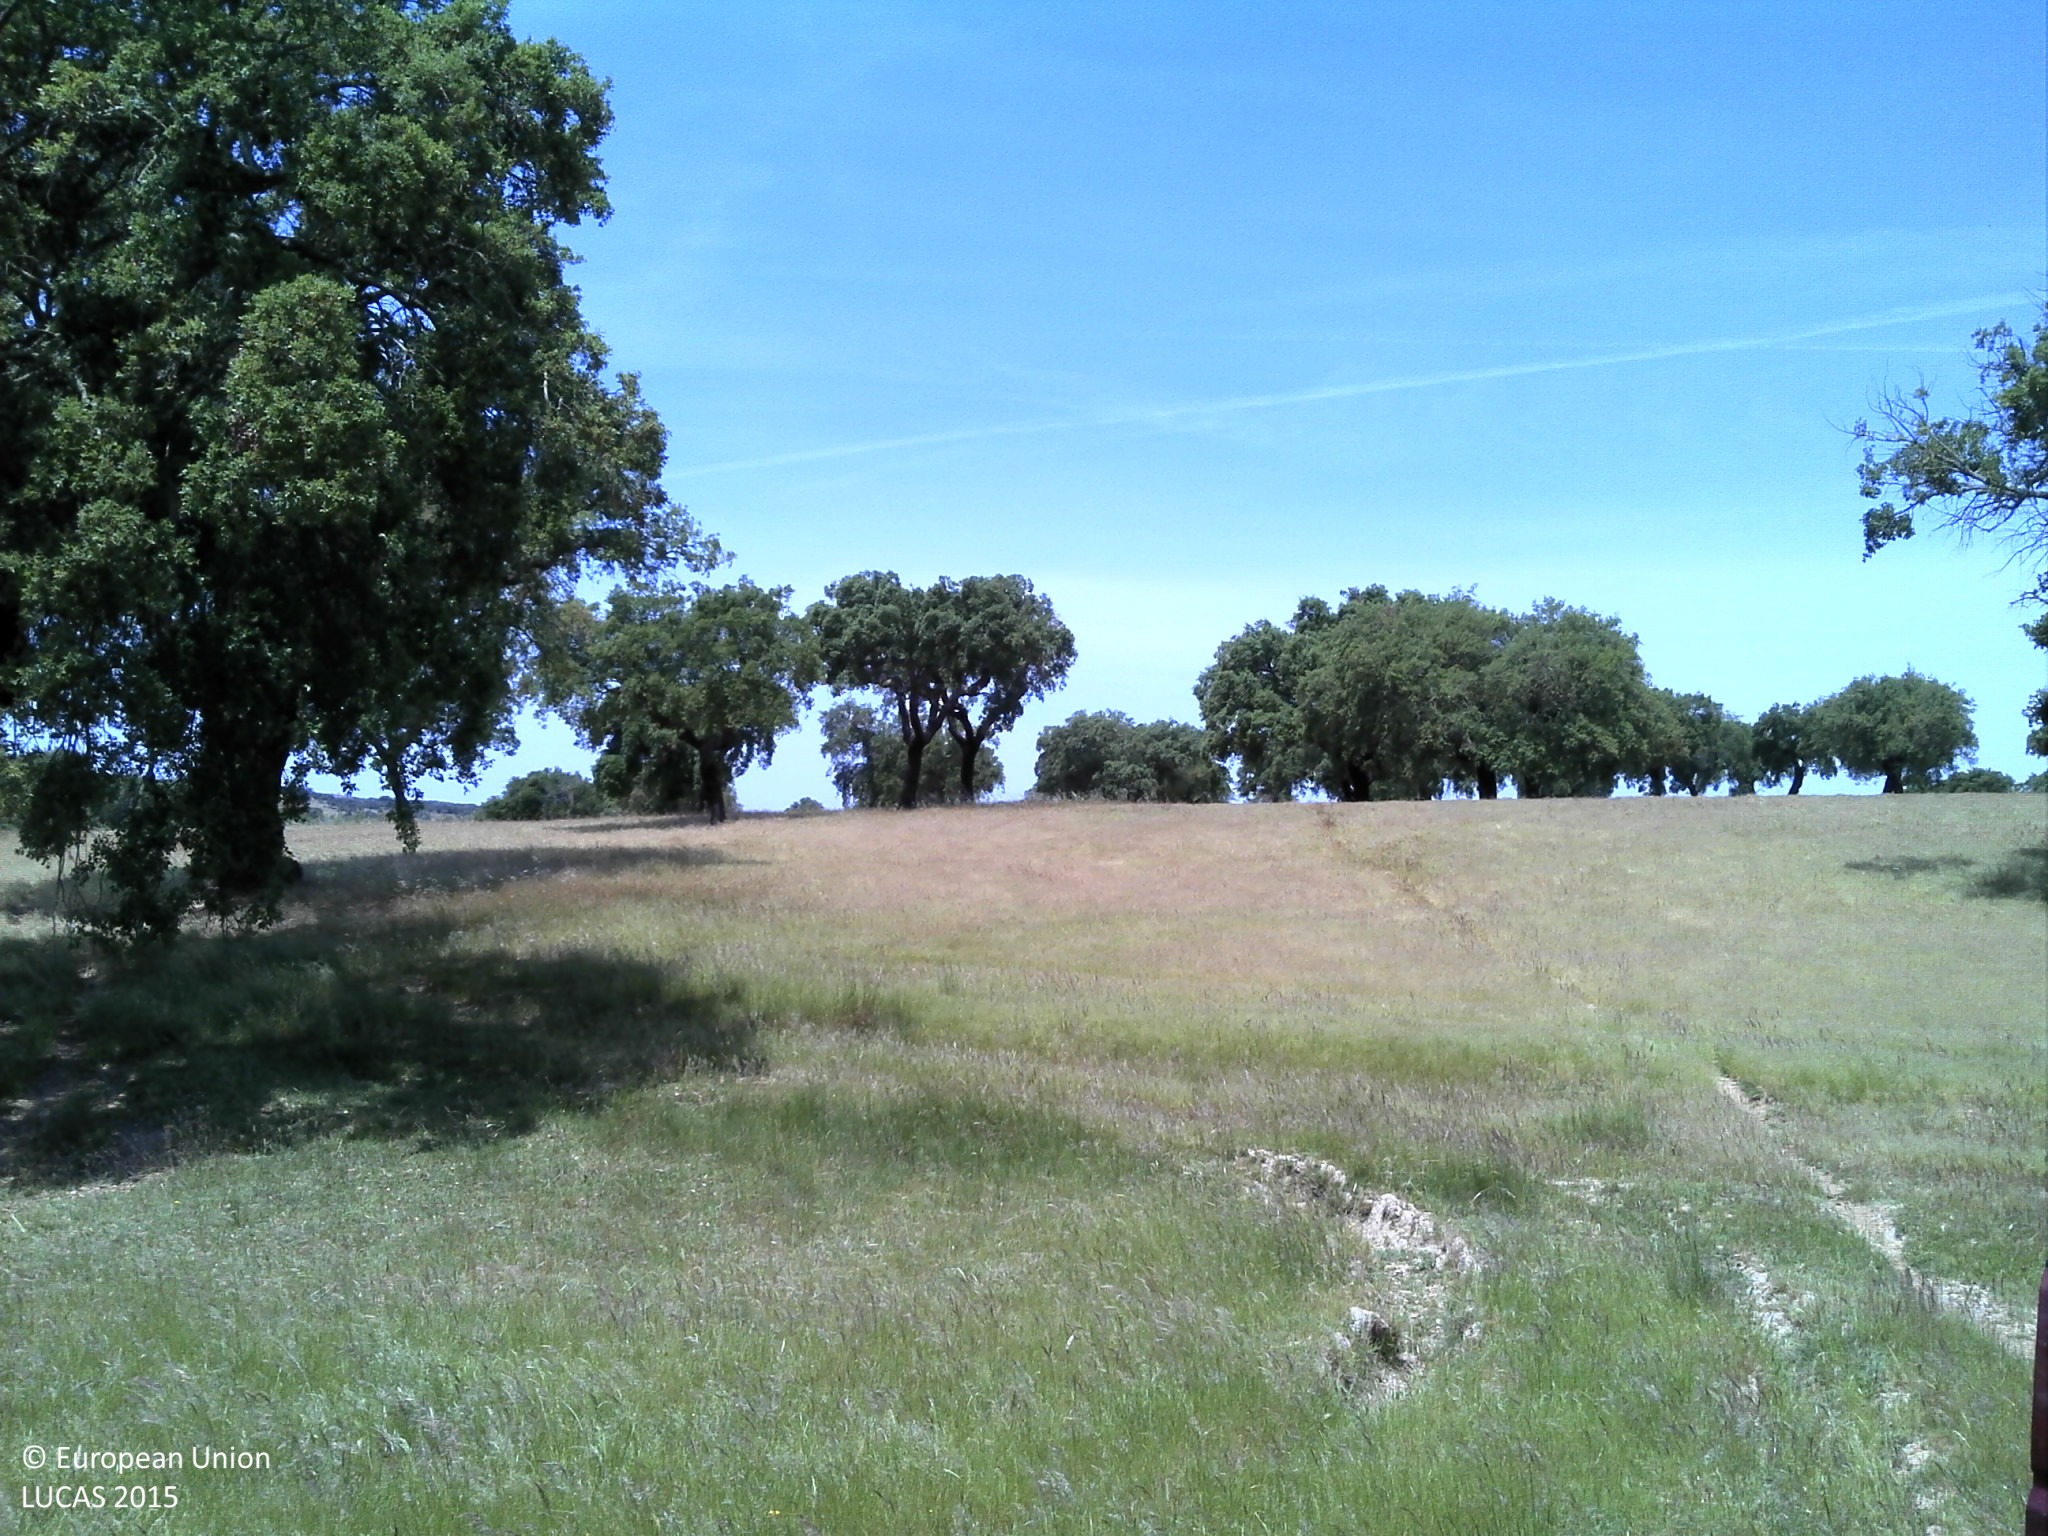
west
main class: Woodland
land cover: Broadleaved woodland
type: broadleaved evergreen forest
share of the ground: 10 - 25 %
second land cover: Grassland without tree/shrub cover
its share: 50 - 75 %
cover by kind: herbaceous plants 75 %, unconsolidated bare surface 15 %, broadleaved forest trees 10 %
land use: Forestry
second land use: Agriculture (excluding fallow land and kitchen gardens)
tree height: > 5 m
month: May
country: PT
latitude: 39.1132
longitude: -7.6573
